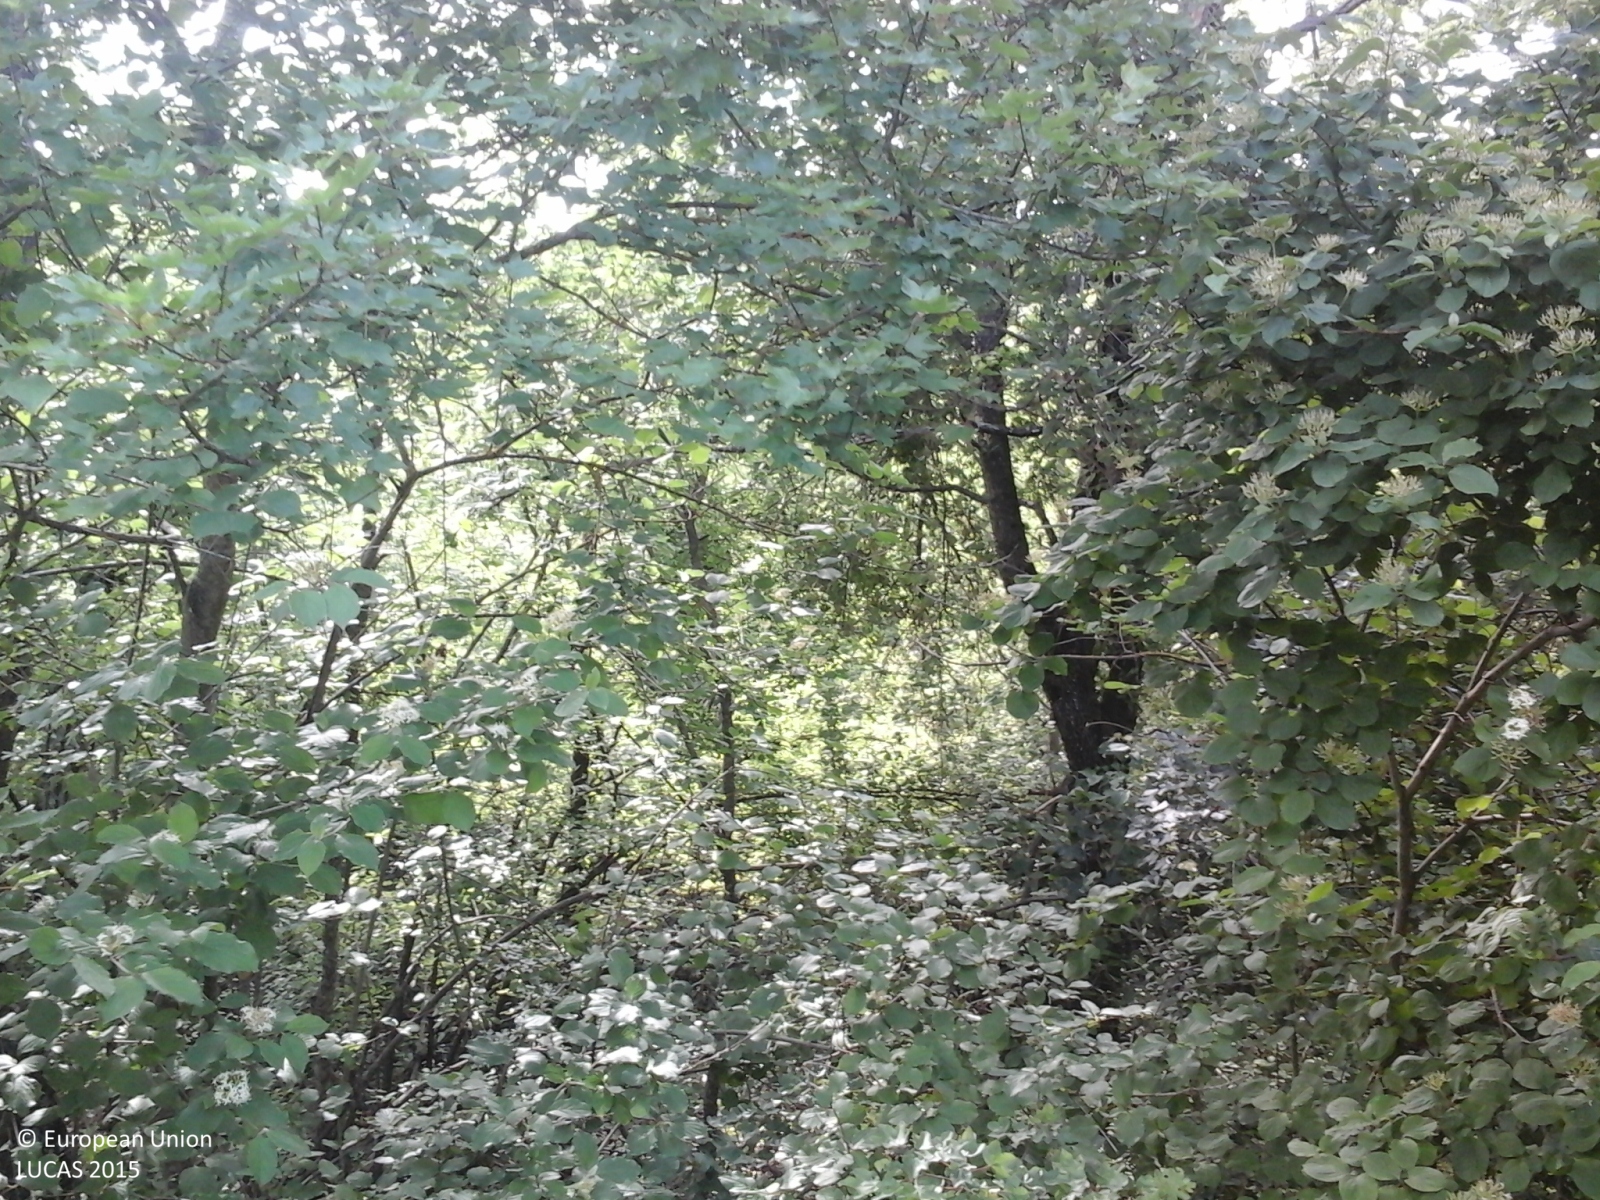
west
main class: Woodland
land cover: Broadleaved woodland
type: thermophilous deciduous forest
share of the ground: > 75 %
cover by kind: broadleaved forest trees 85 %, shrubs 10 %, herbaceous plants 5 %
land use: Forestry
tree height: > 5 m
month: May
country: IT
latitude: 44.2355
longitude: 11.1867
